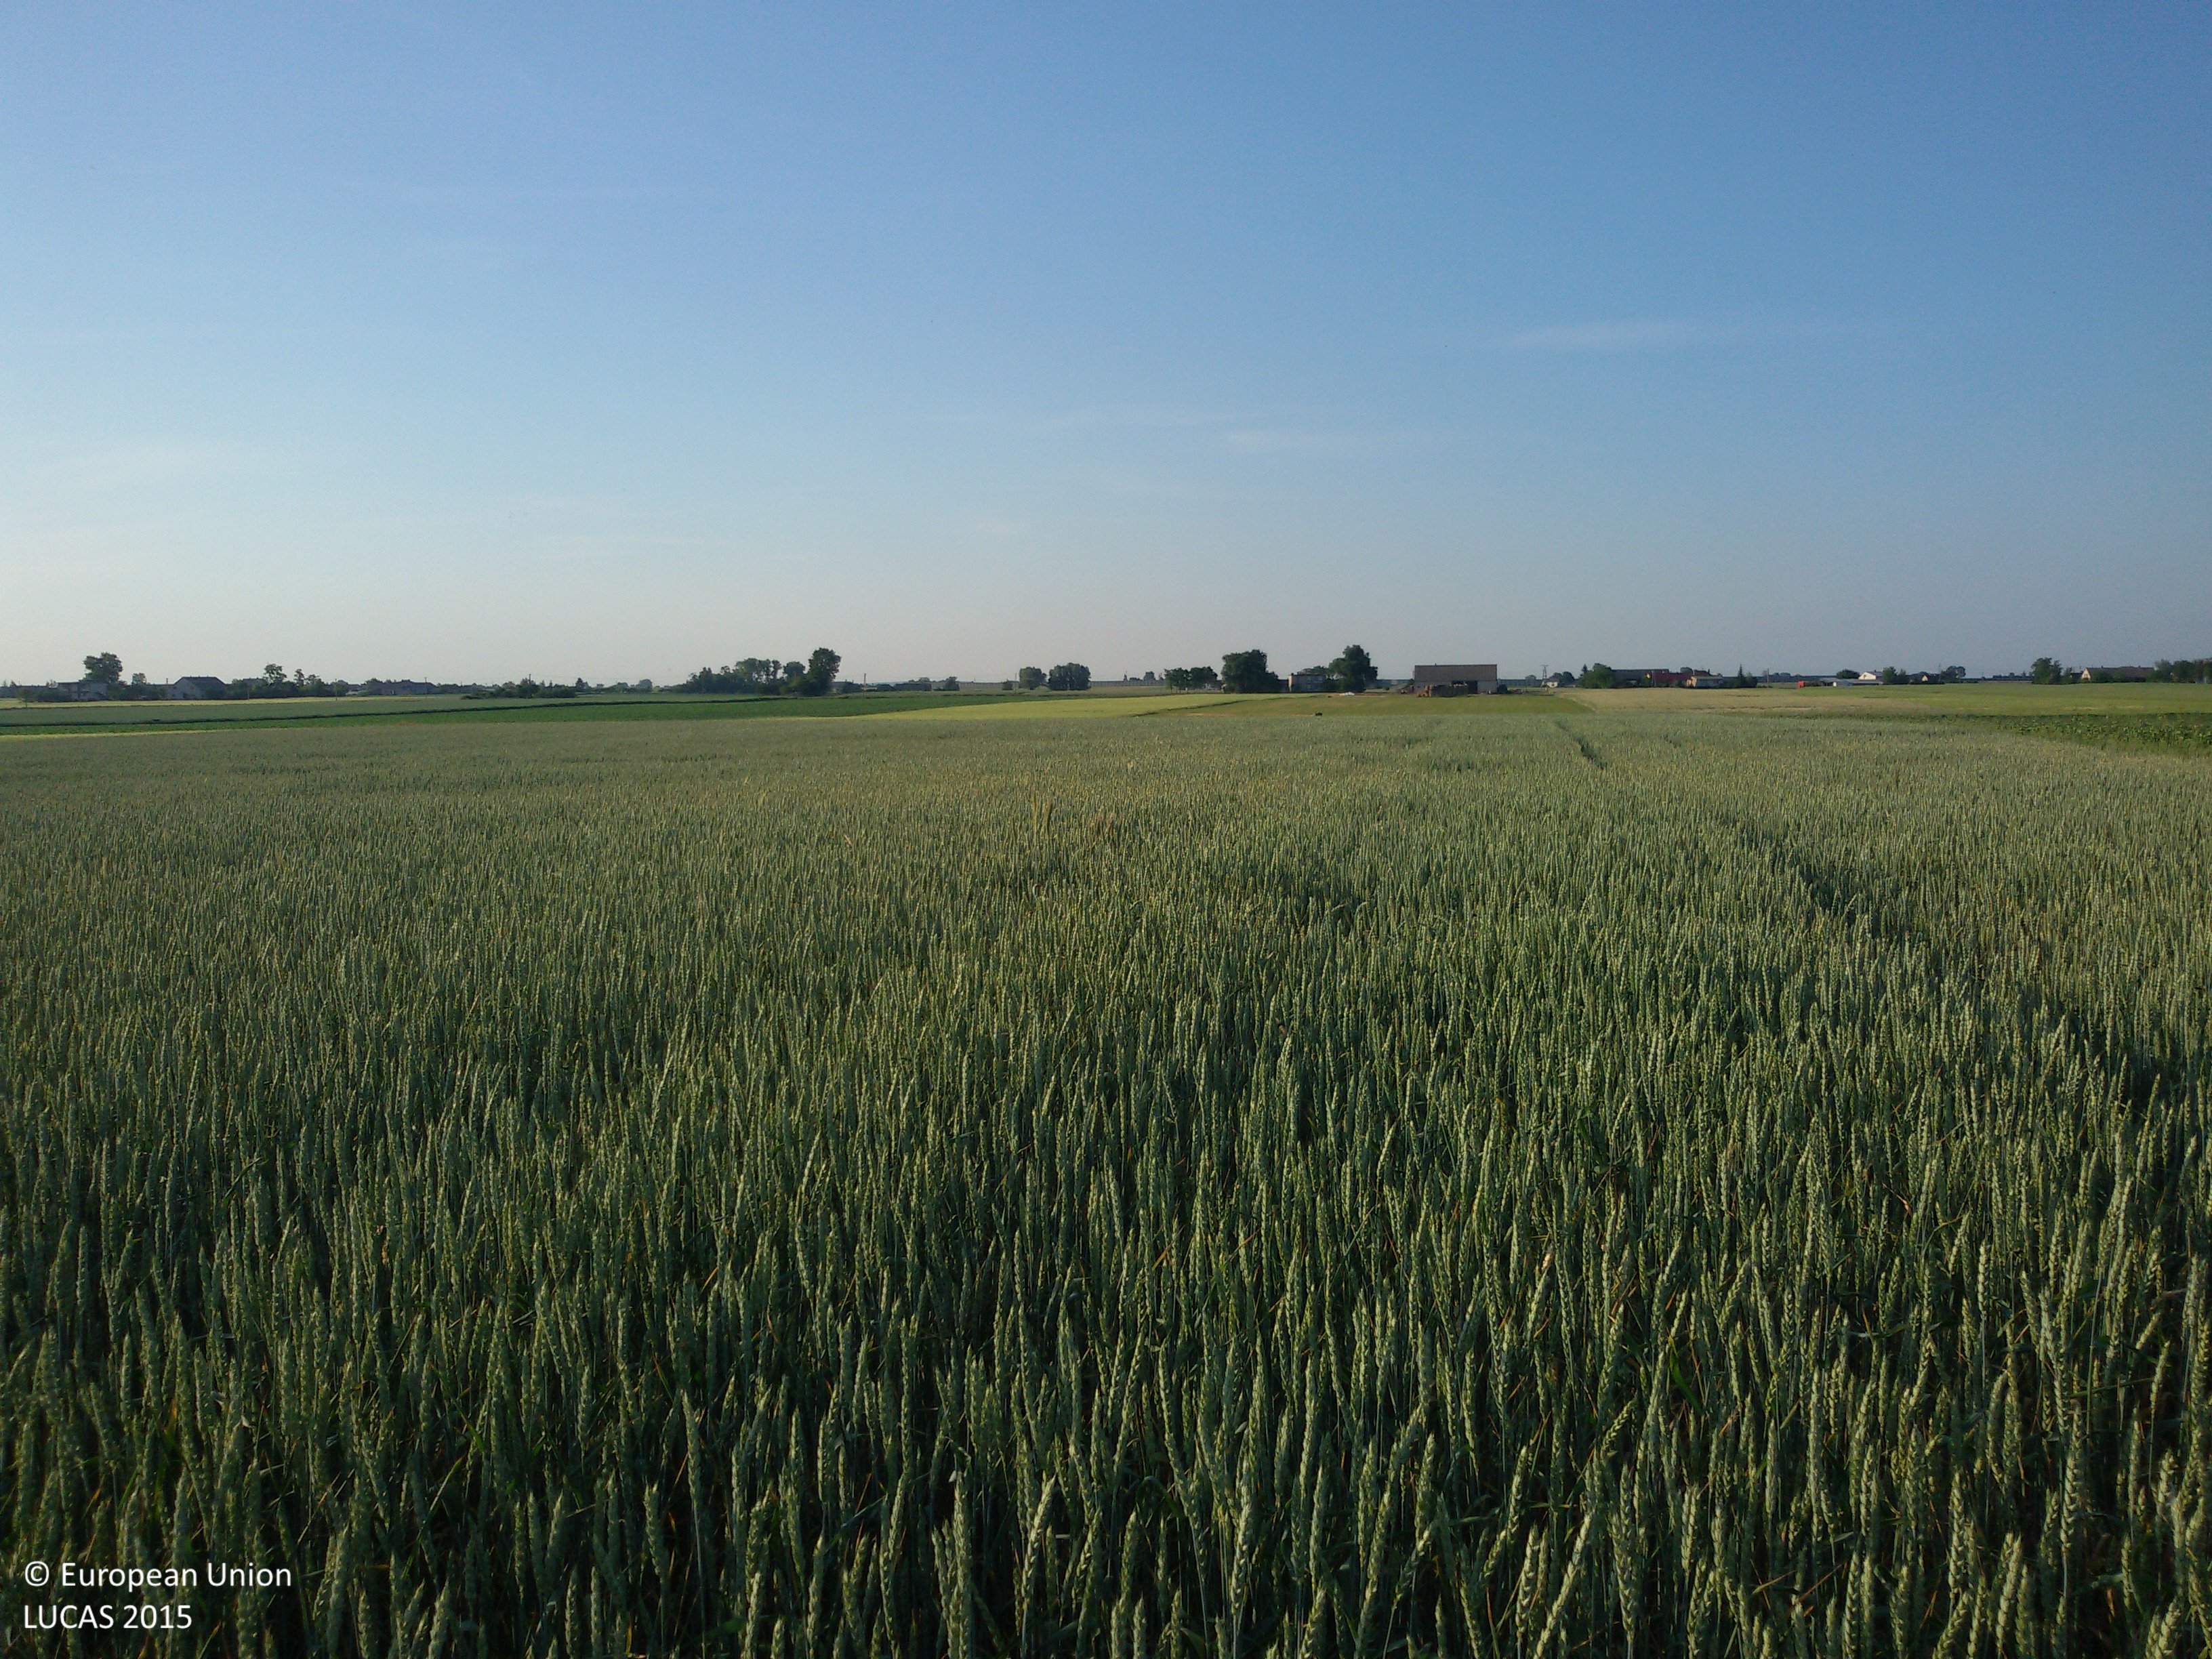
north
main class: Cropland
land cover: Common wheat
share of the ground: > 75 %
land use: Agriculture (excluding fallow land and kitchen gardens)
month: June
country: PL
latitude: 52.5192
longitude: 19.0574
